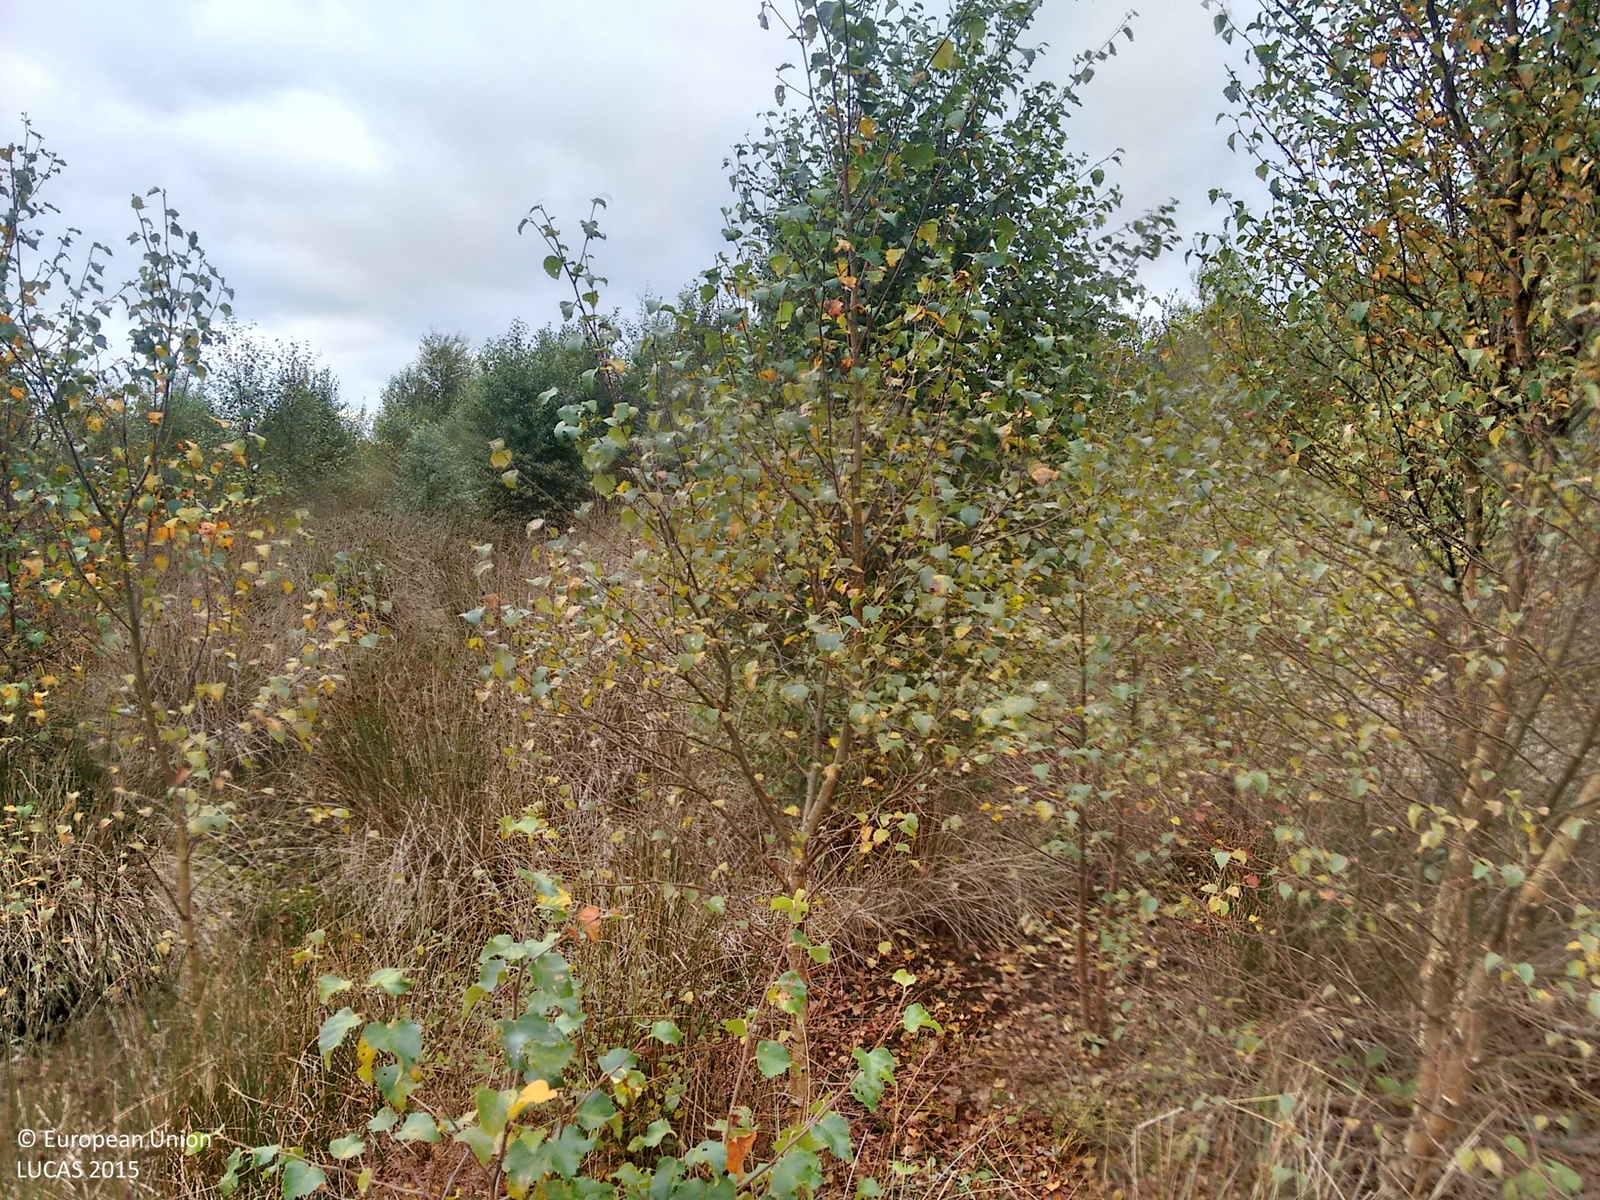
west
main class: Woodland
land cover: Broadleaved woodland
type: acidophilous oak and oak-birch forest
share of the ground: > 75 %
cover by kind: broadleaved forest trees 75 %, herbaceous plants 20 %, lichens and mosses 5 %
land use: Semi-natural and natural areas not in use
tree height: > 5 m
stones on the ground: < 10 %
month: October
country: IE
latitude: 53.1856
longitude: -7.8436
